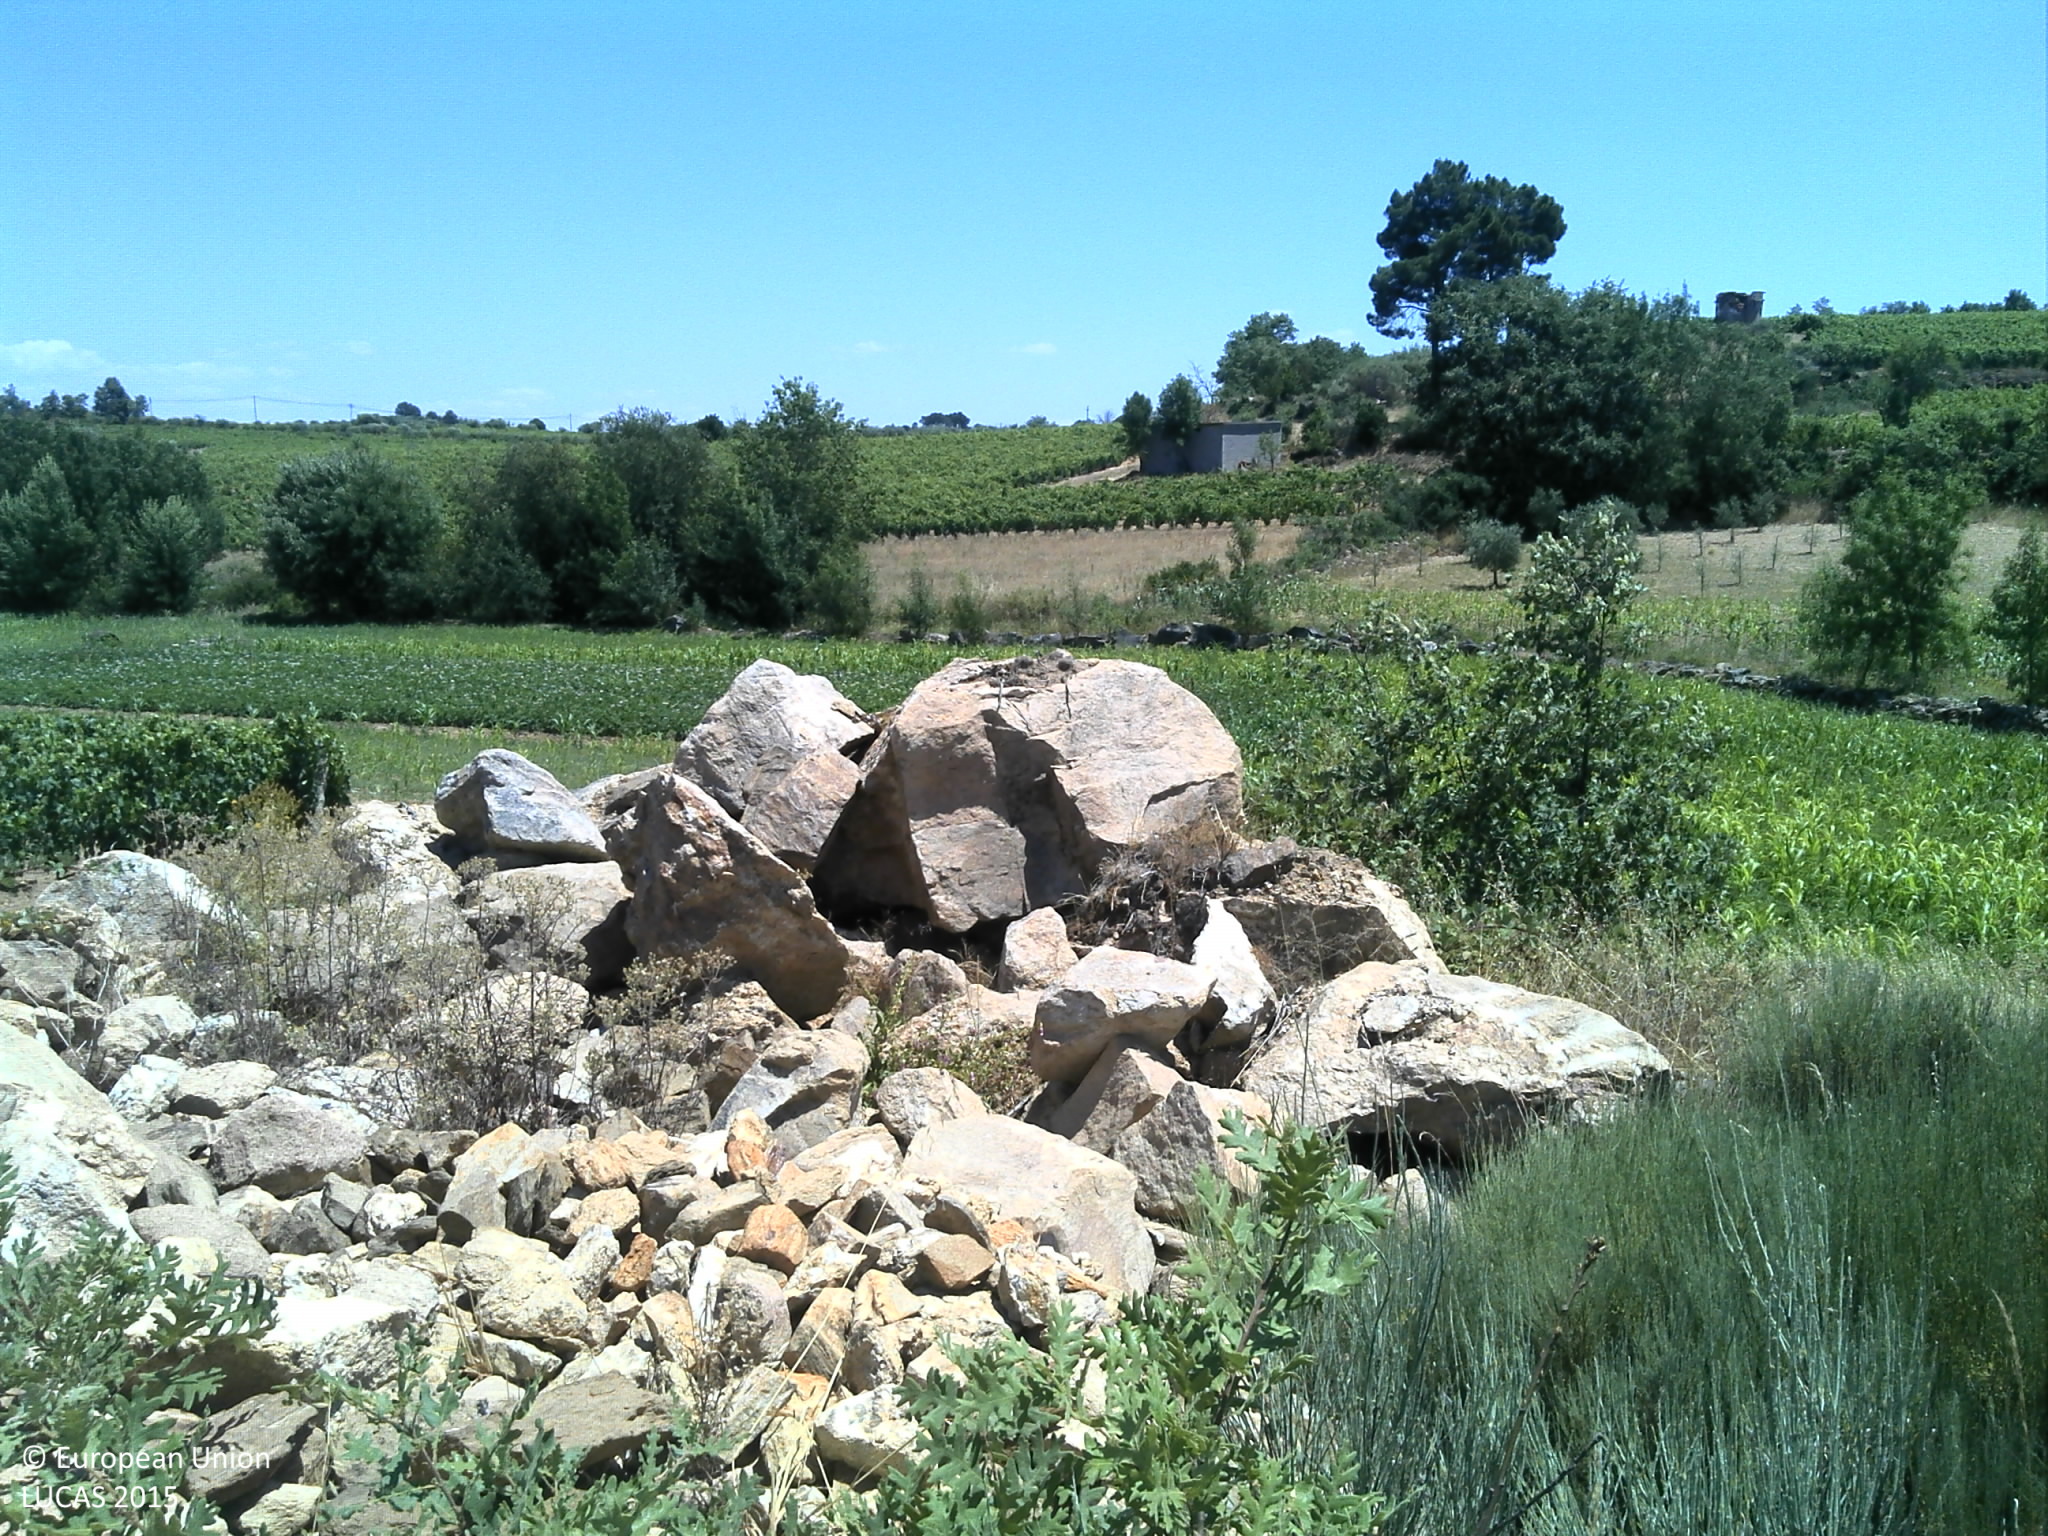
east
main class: Shrubland
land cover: Shrubland without tree cover
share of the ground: 50 - 75 %
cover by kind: shrubs 50 %, consolidated bare surface 30 %, herbaceous plants 10 %, unconsolidated bare surface 10 %
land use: Abandoned areas
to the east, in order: Shrubland without tree cover; Rocks and stones; Grassland without tree/shrub cover; Maize; Potatoes; Dry stone walls; Abandoned hedges; Rivers and streams; Shruby margins; Dry stone walls; Oats; Vineyards; Grassland without tree/shrub cover; Abandoned hedges; Artificial constructions in urban areas; Shruby margins; Tracks; Dry stone walls; Abandoned hedges; Tracks; Grass margins; Olive groves; Vineyards
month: June
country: PT
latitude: 40.7719
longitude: -7.1559
